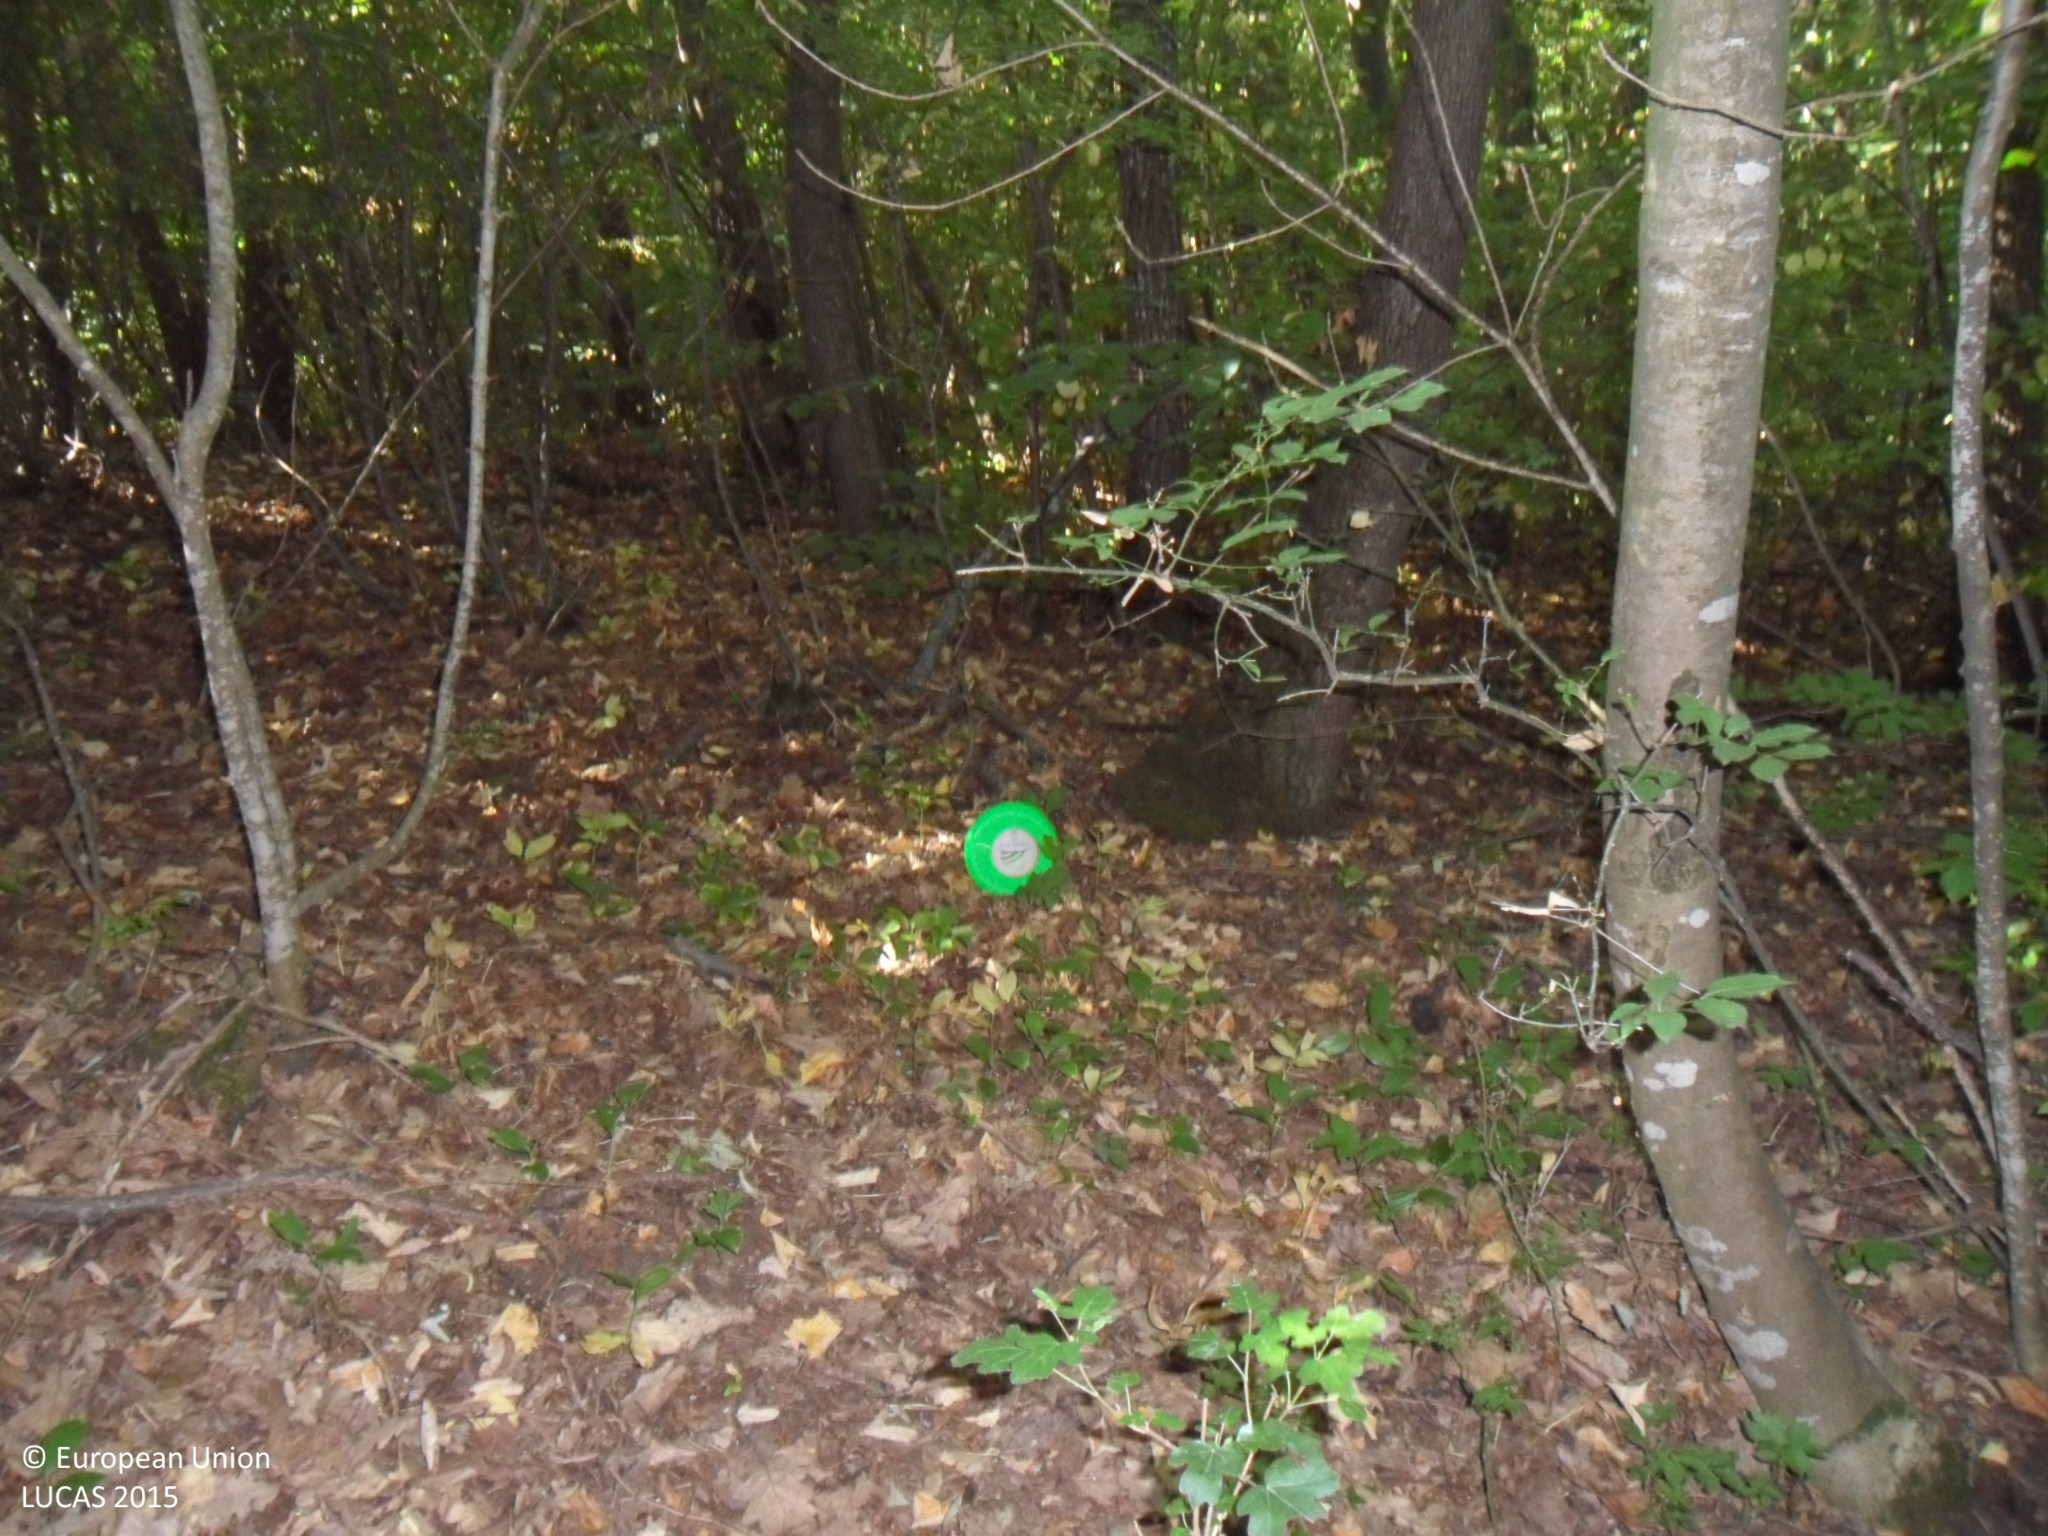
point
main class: Woodland
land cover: Broadleaved woodland
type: beech forest
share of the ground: > 75 %
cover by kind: broadleaved forest trees 100 %
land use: Forestry
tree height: > 5 m
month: July
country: BG
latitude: 43.3250
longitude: 26.8710
